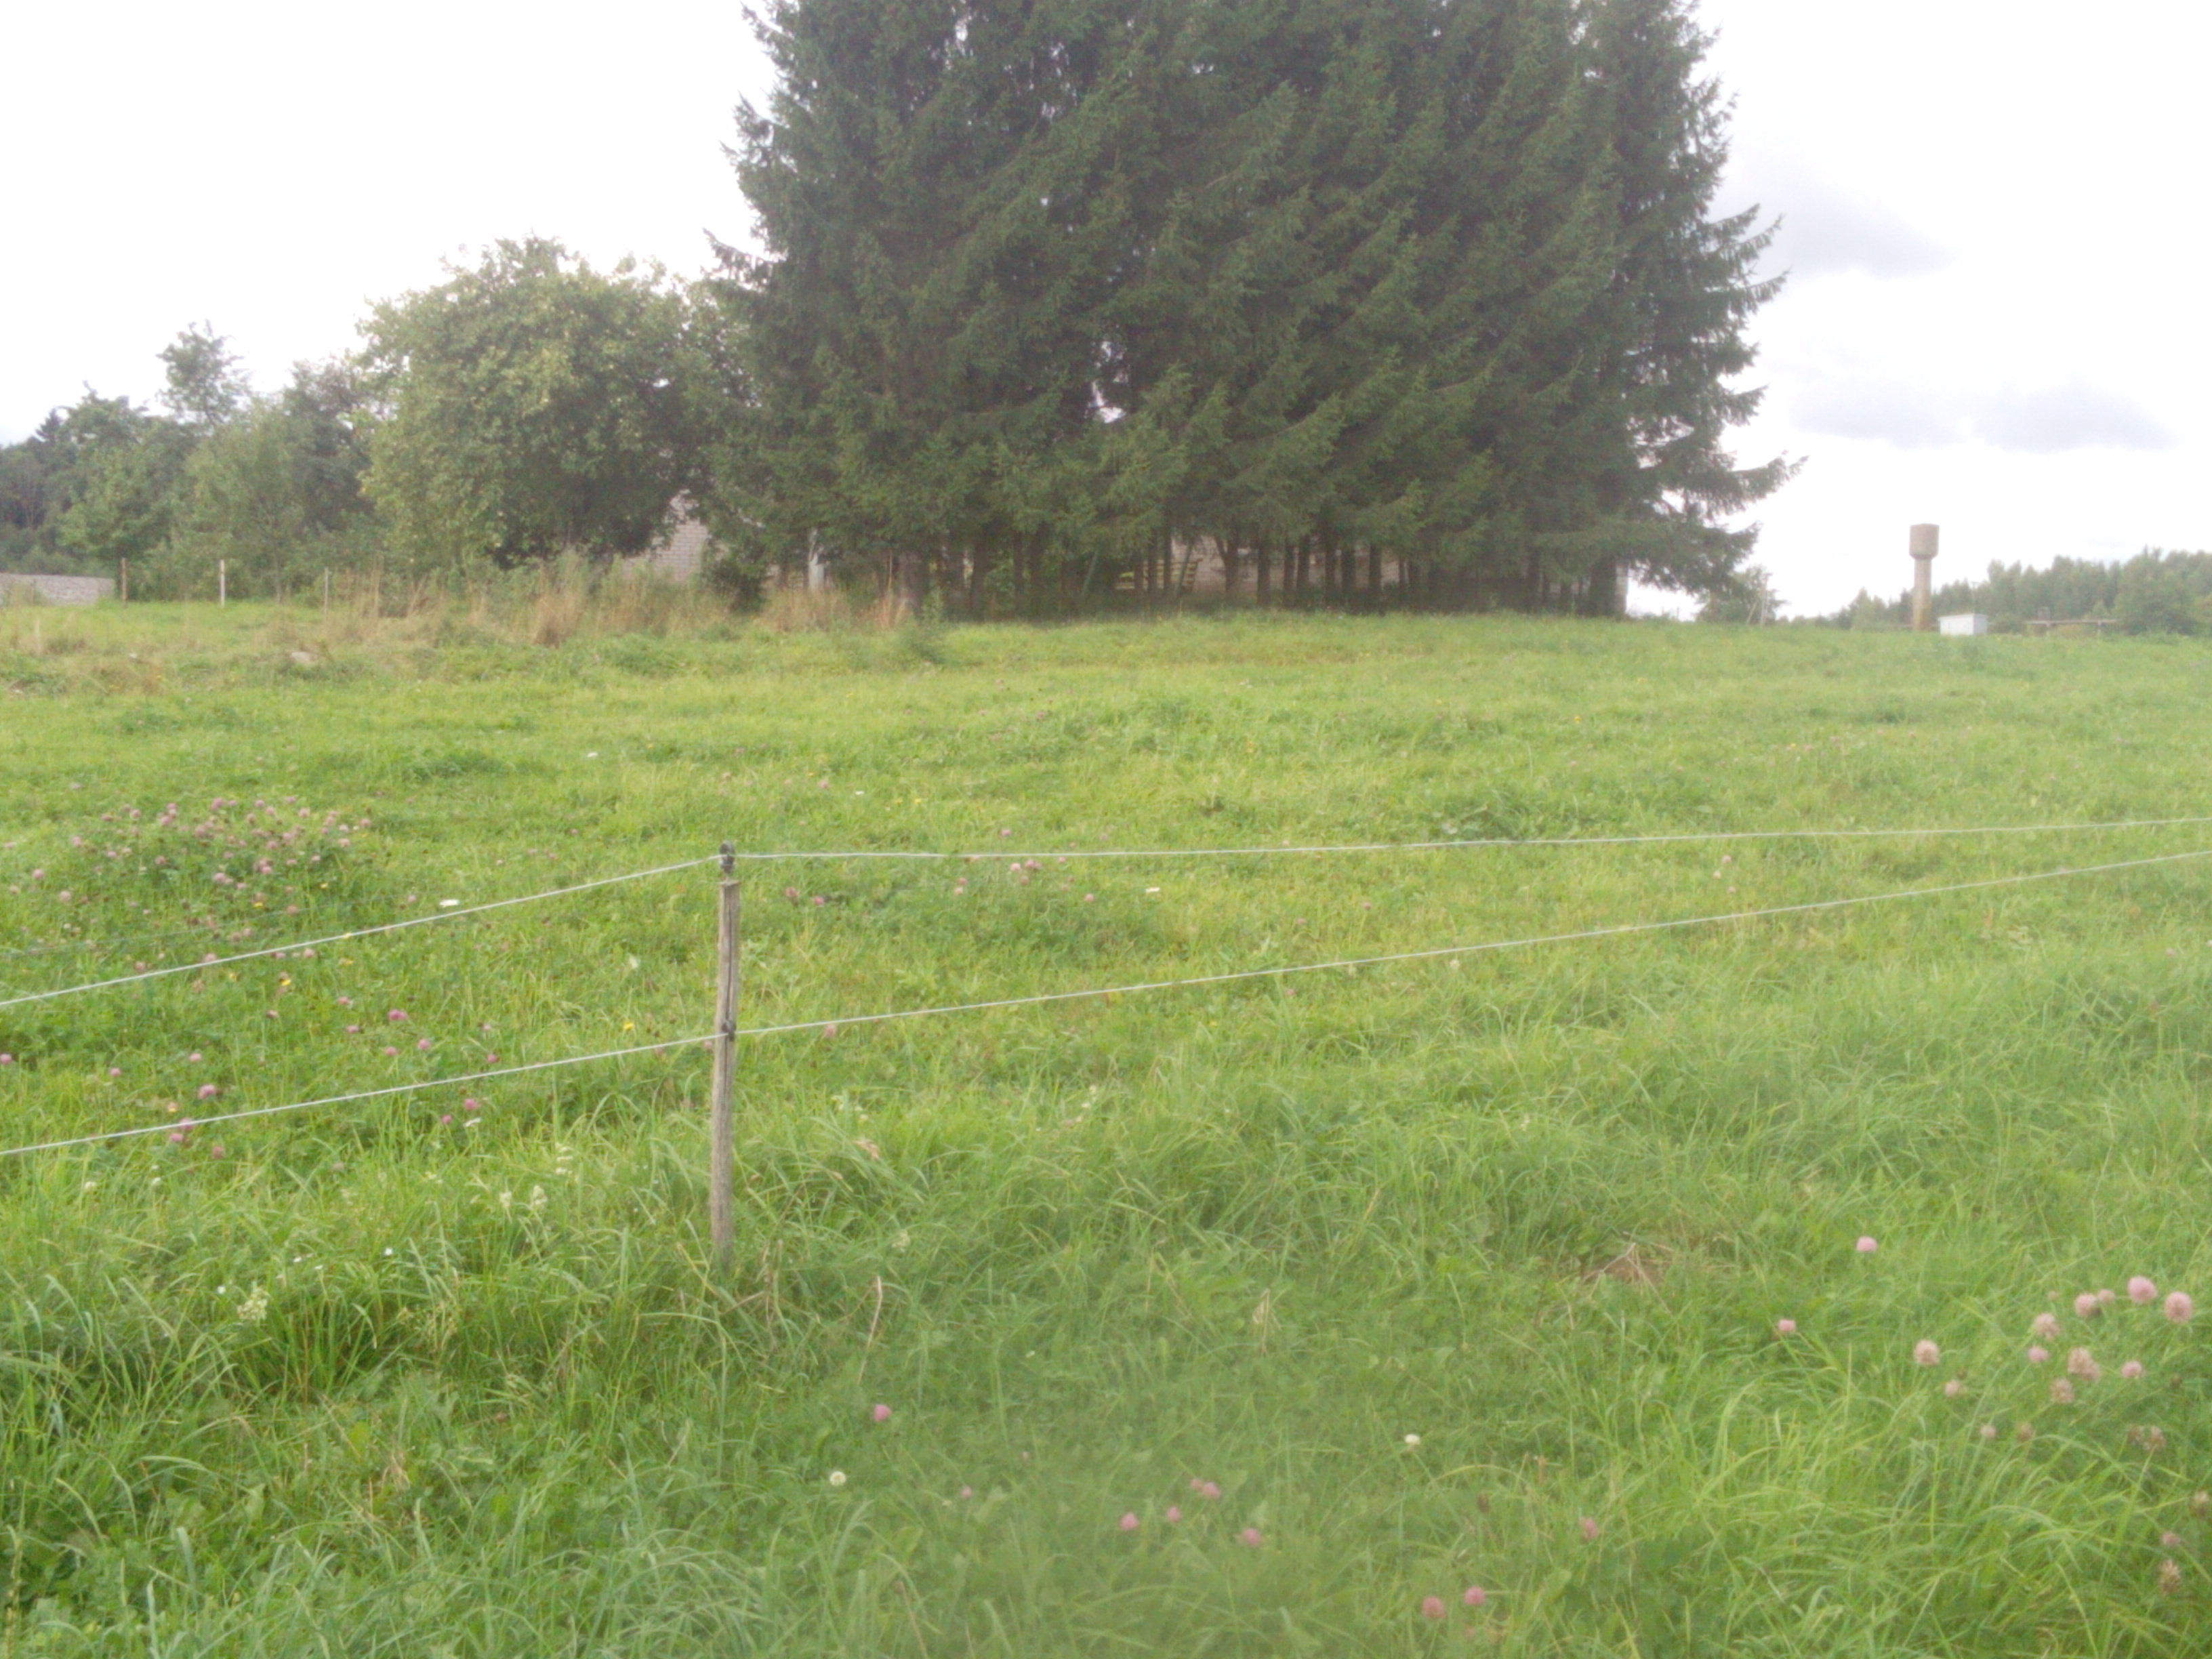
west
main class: Grassland
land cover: Grassland without tree/shrub cover
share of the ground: > 75 %
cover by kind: herbaceous plants 100 %
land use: Agriculture (excluding fallow land and kitchen gardens)
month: September
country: LT
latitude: 55.8559
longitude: 22.4071
